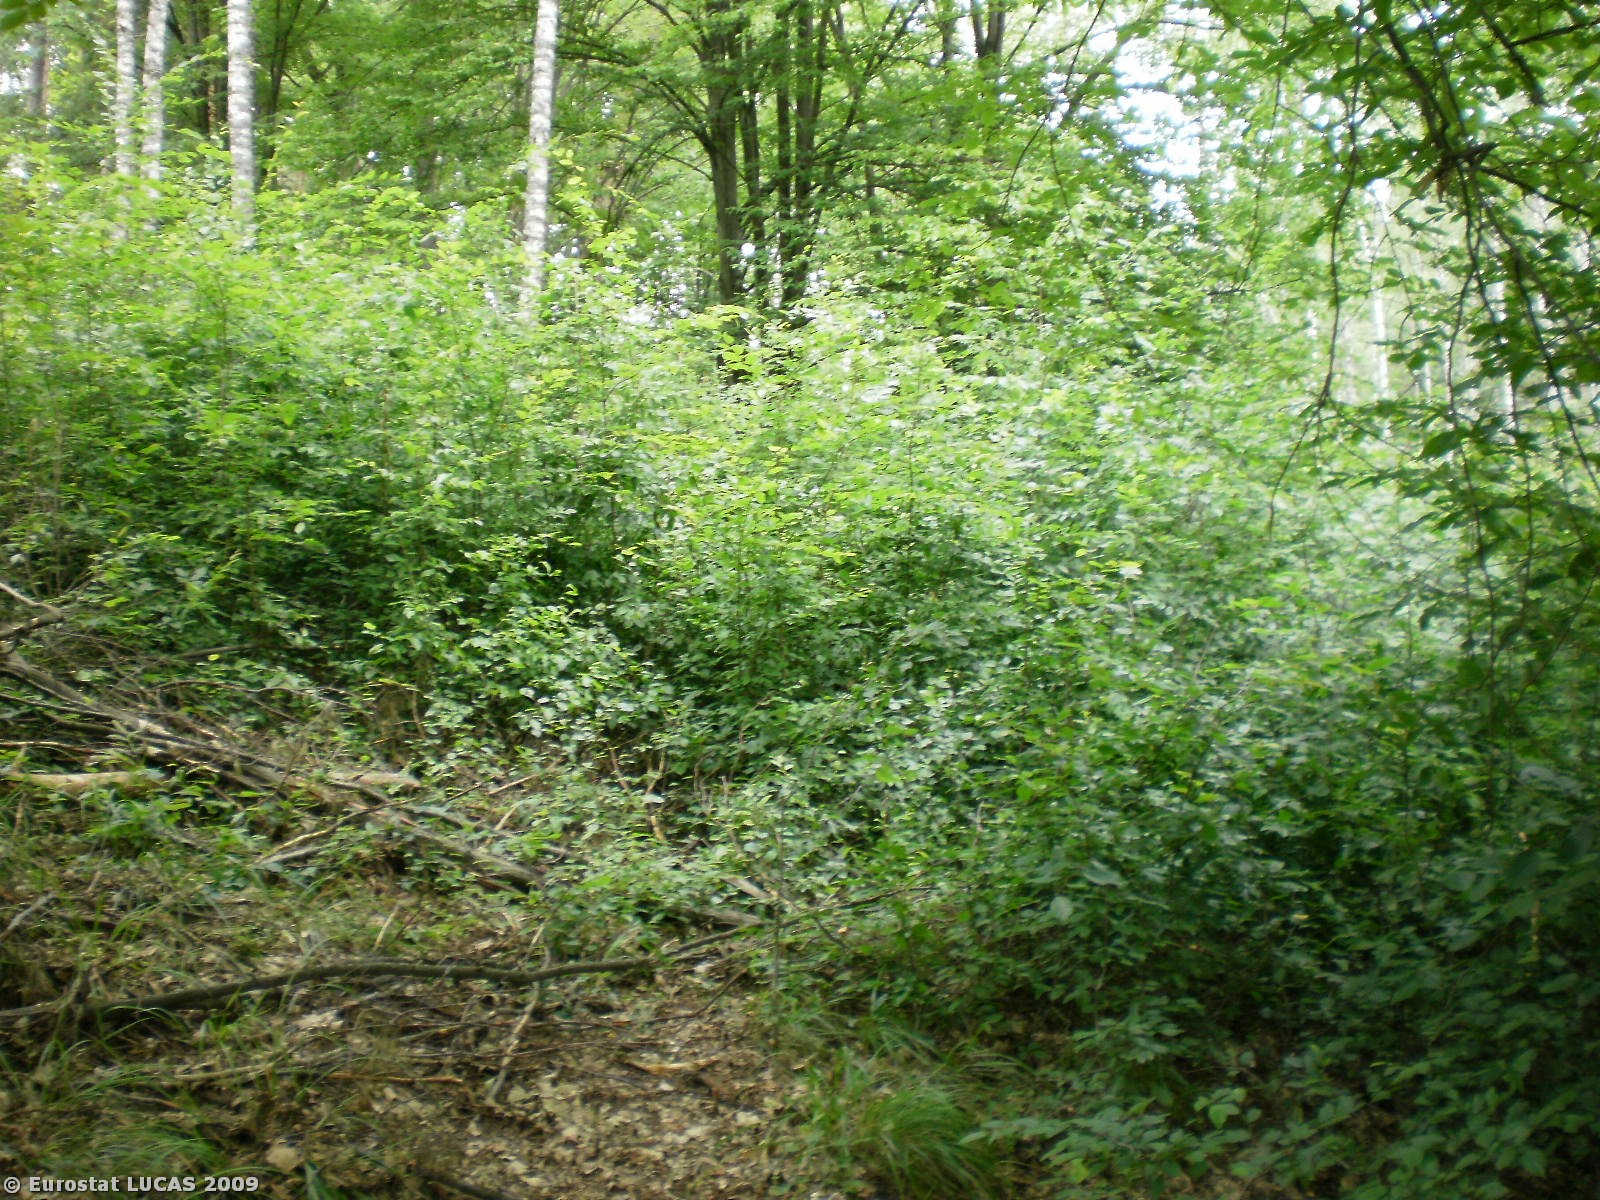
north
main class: Woodland
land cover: Broadleaved woodland
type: mesophytic deciduous forest
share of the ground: > 75 %
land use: Forestry
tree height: > 5 m
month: July
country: PL
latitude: 53.7890
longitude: 19.9426
